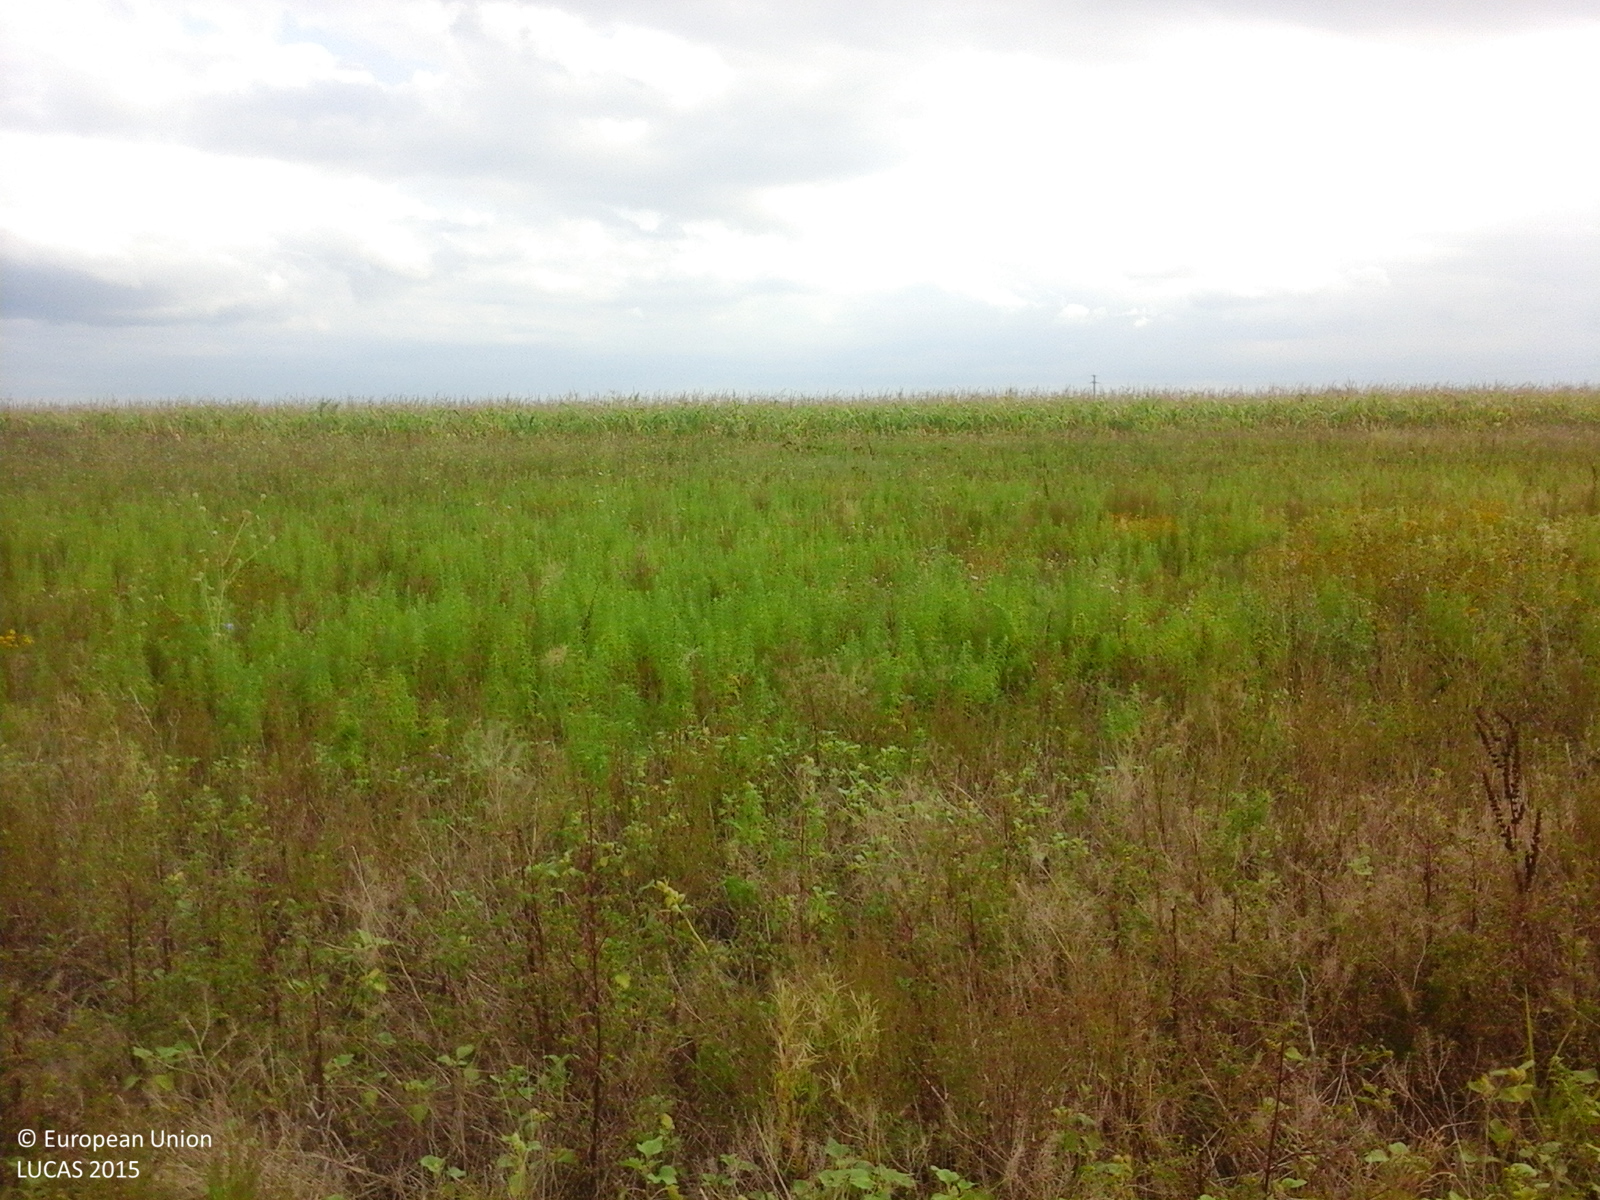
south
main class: Grassland
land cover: Spontaneously vegetated surfaces
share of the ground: > 75 %
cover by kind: herbaceous plants 100 %
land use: Agriculture (excluding fallow land and kitchen gardens)
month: August
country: RO
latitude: 45.6239
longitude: 21.4603
